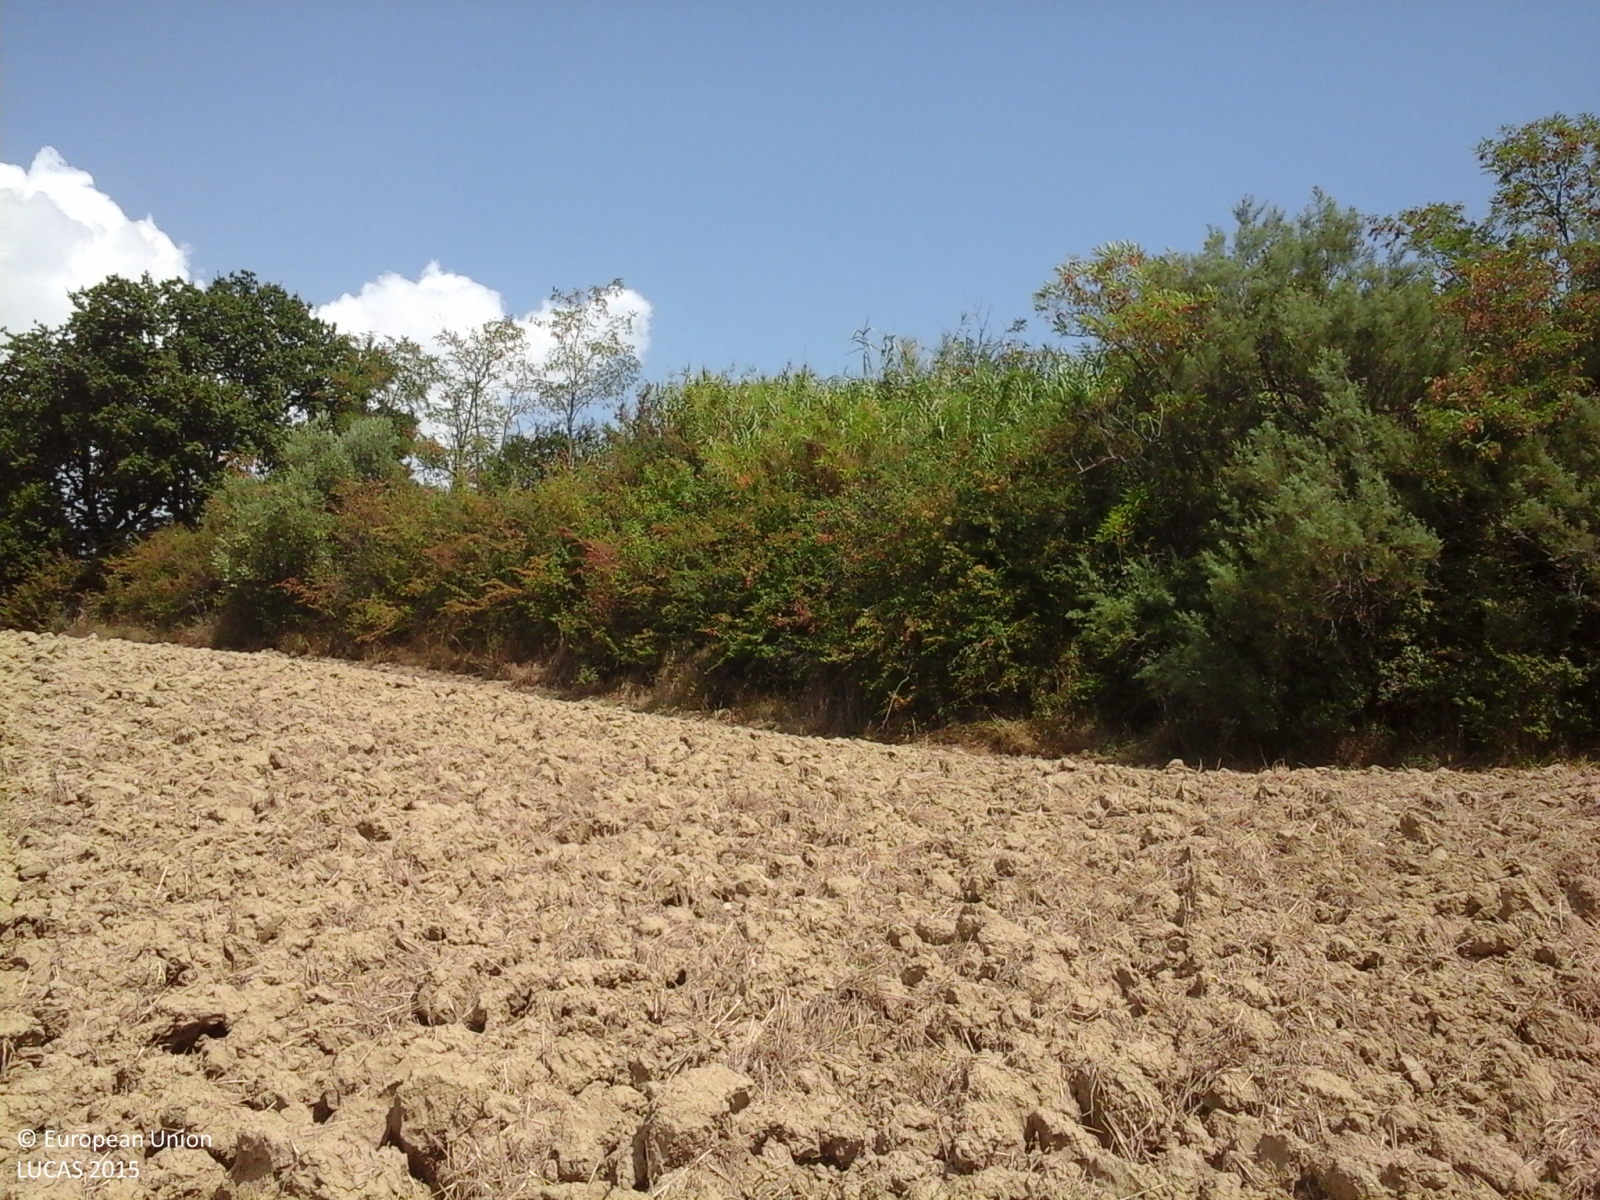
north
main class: Cropland
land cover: Durum wheat
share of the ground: < 10 %
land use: Agriculture (excluding fallow land and kitchen gardens)
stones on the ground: 10 - 25 %
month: August
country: IT
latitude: 43.3972
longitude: 13.2389
